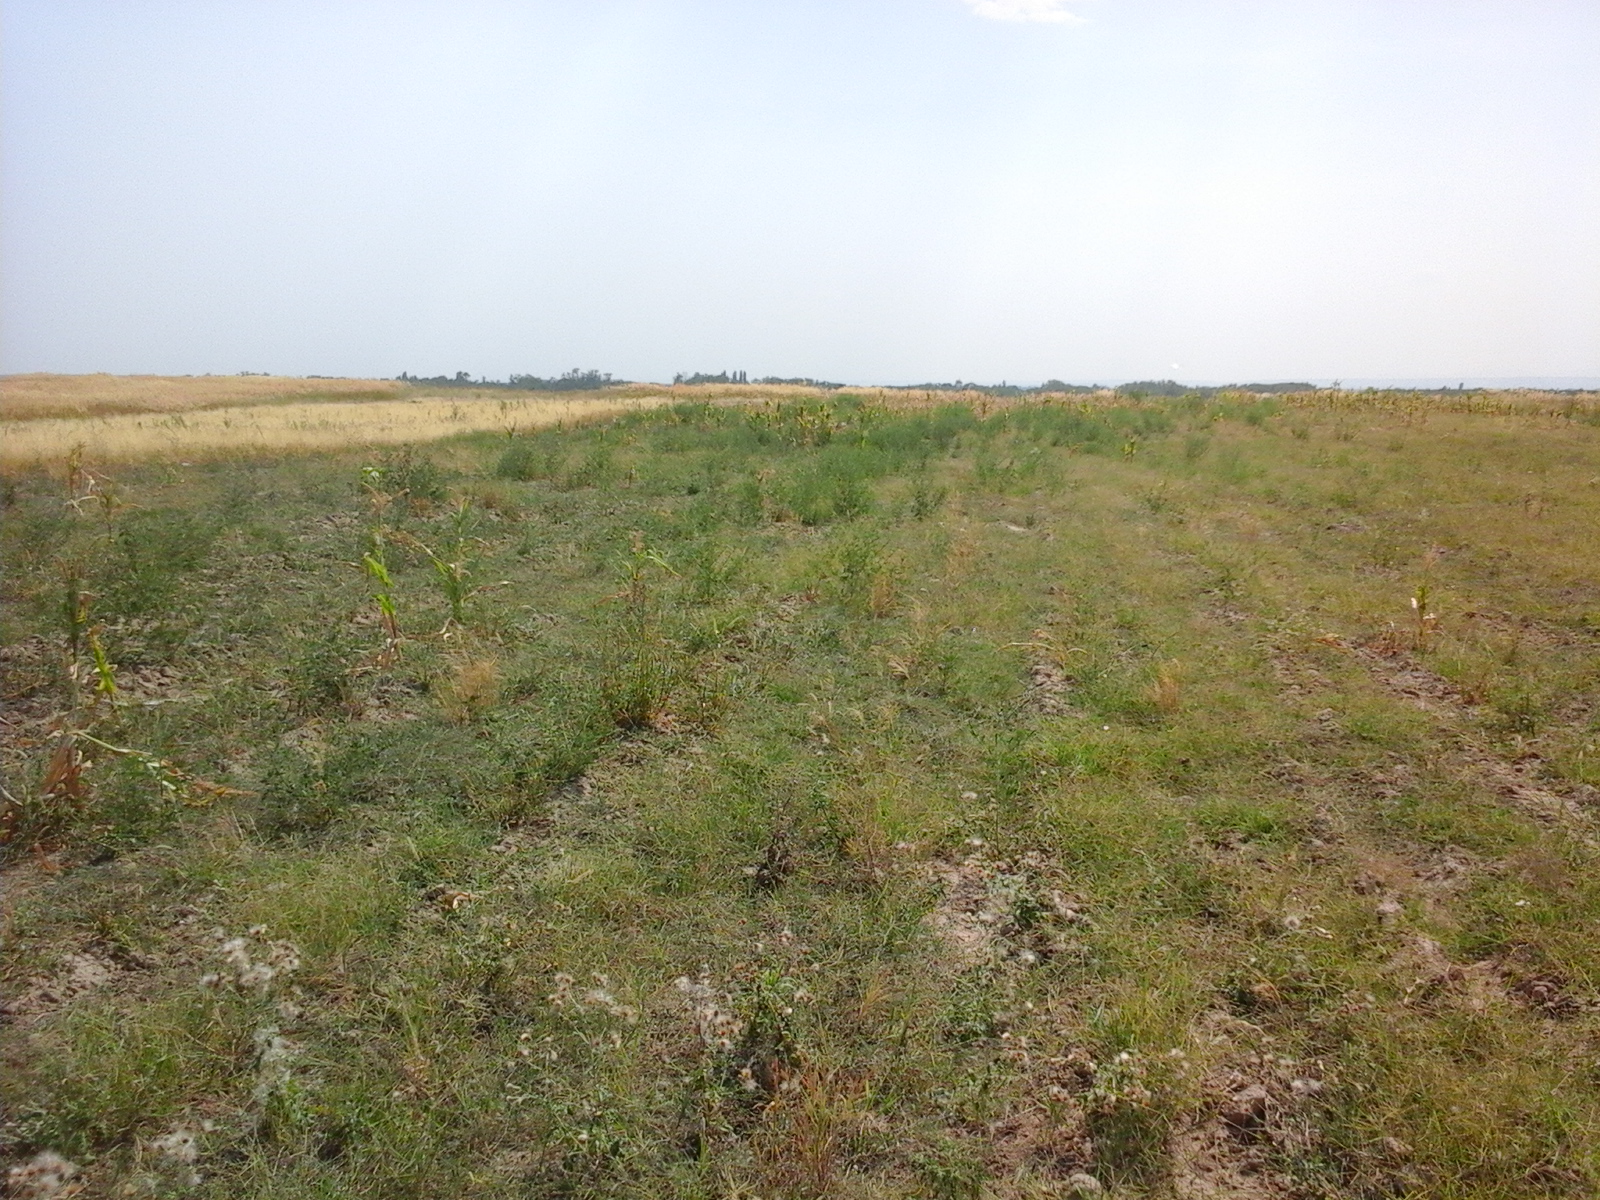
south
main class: Grassland
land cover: Spontaneously vegetated surfaces
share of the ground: > 75 %
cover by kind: herbaceous plants 100 %
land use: Fallow land
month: August
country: RO
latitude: 44.4815
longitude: 22.6765
